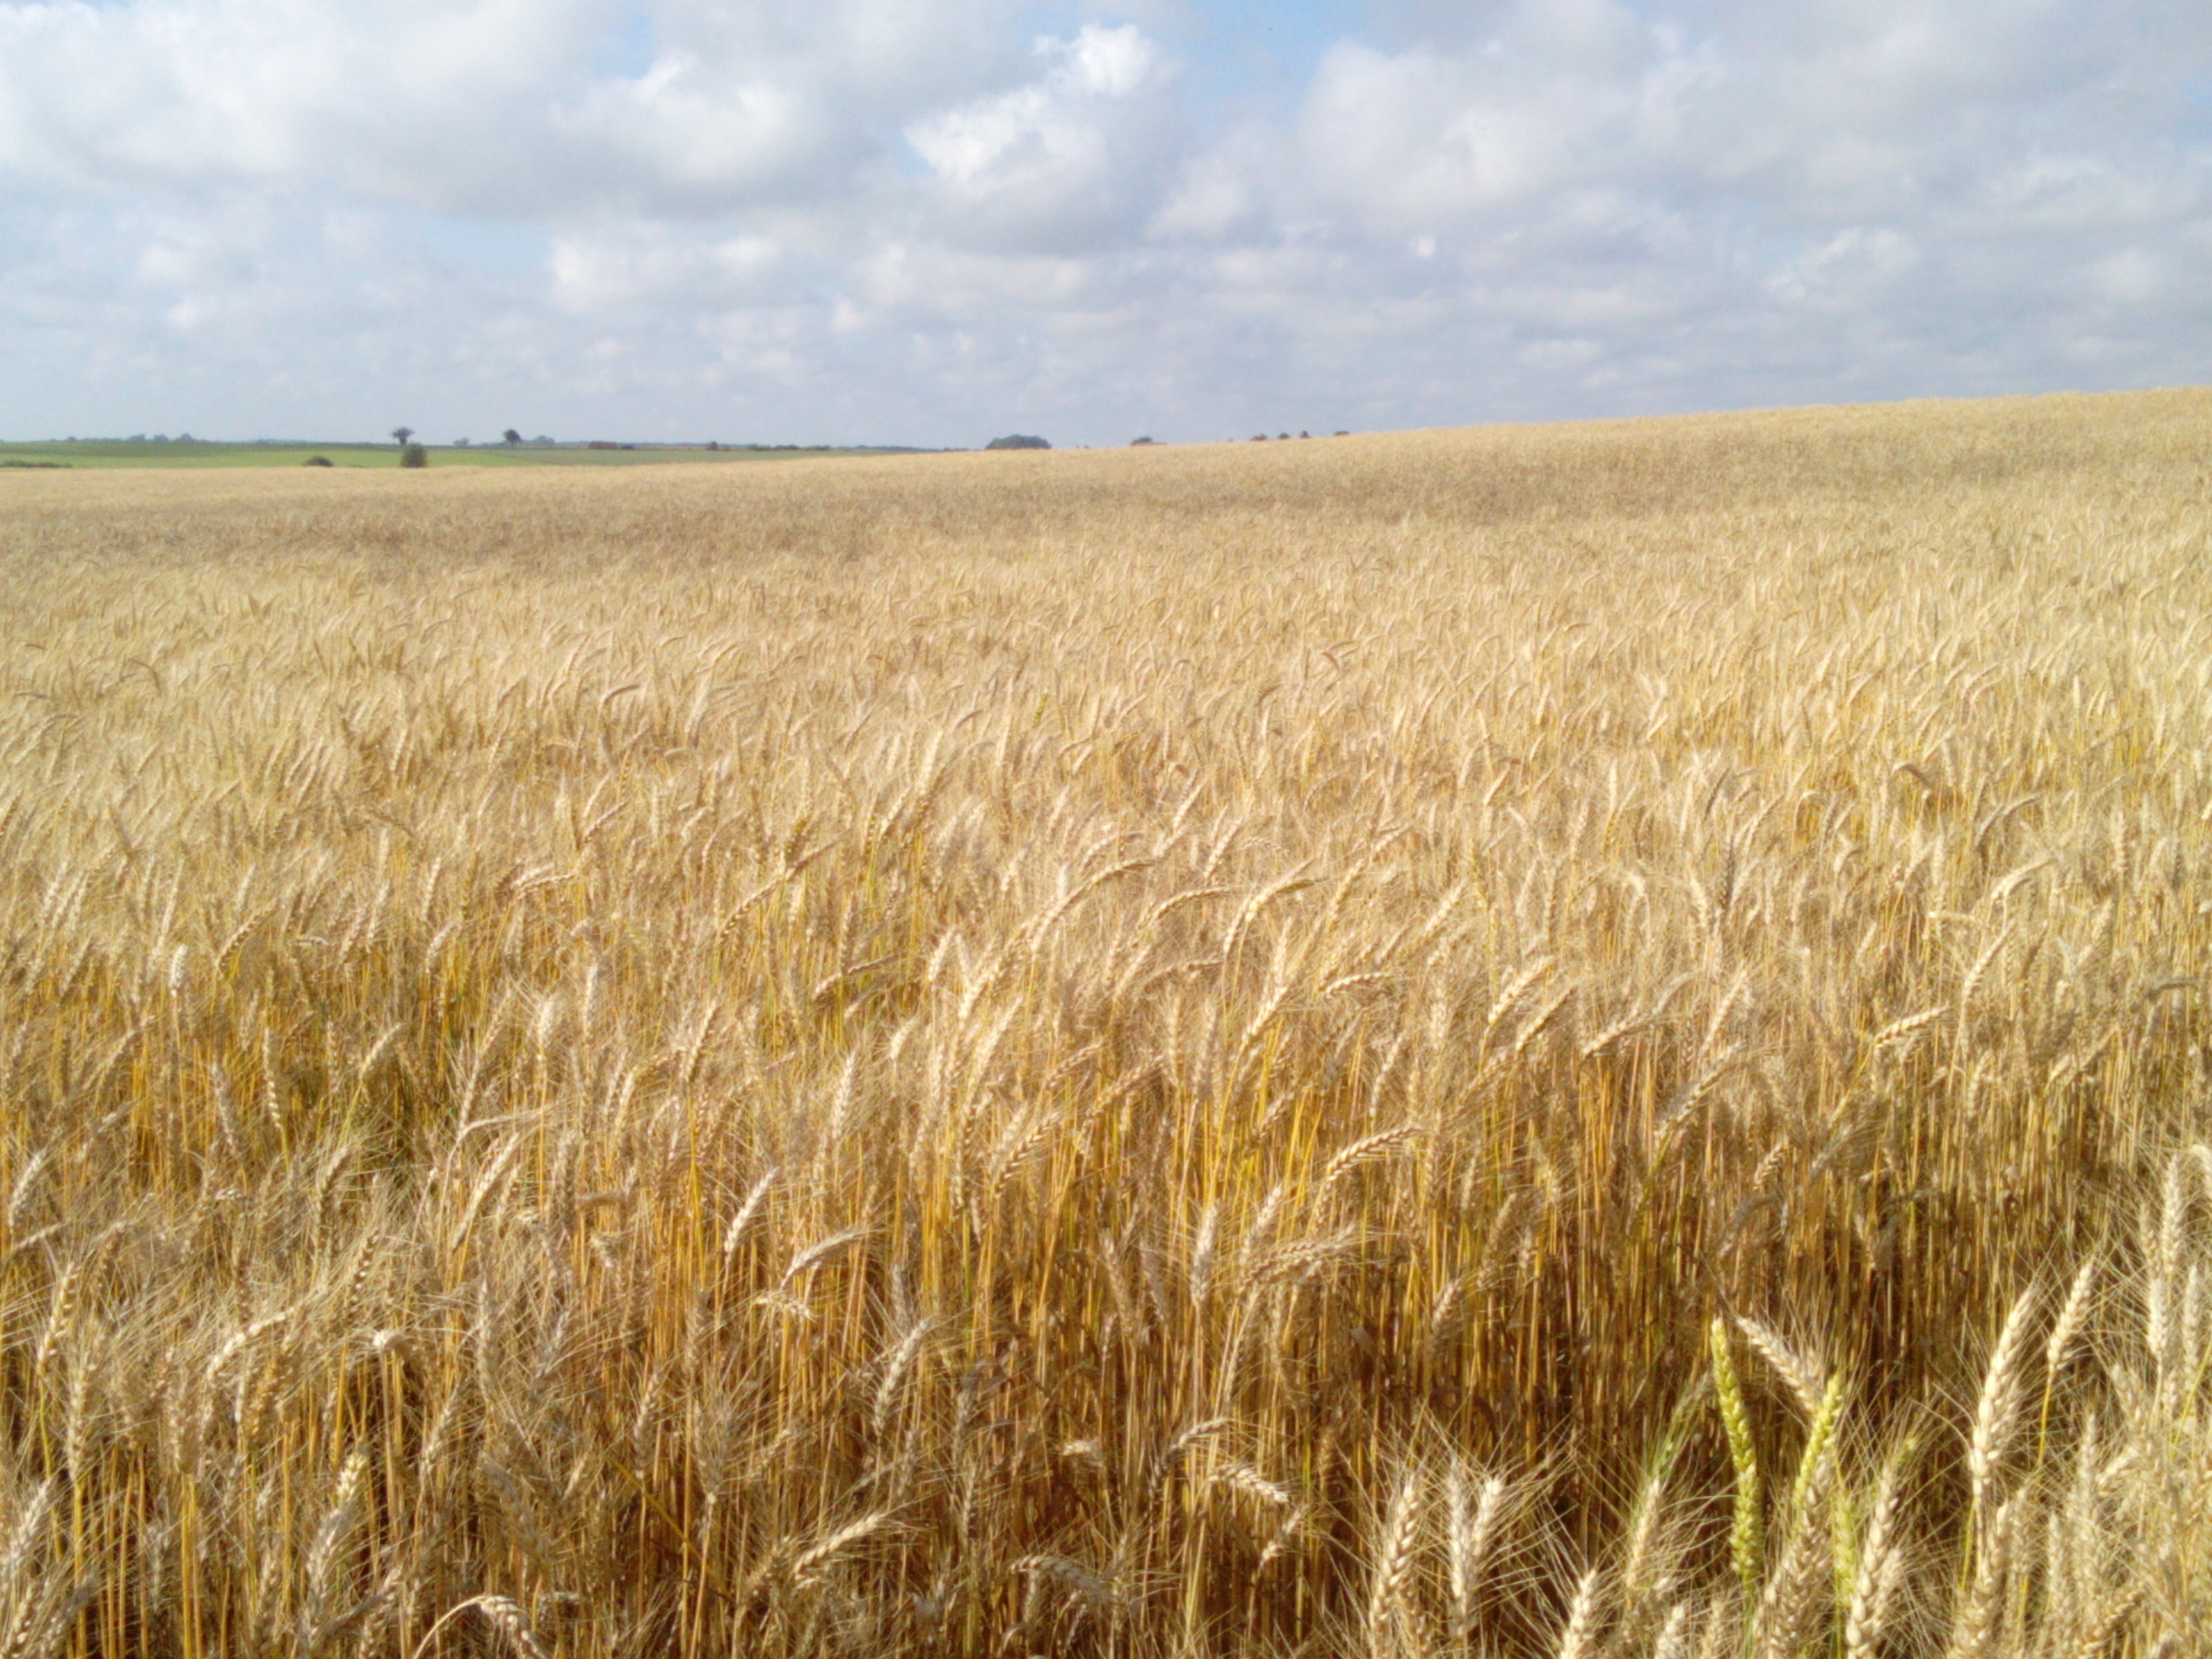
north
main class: Cropland
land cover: Common wheat
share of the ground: > 75 %
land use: Agriculture (excluding fallow land and kitchen gardens)
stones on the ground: 10 - 25 %
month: July
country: LV
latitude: 56.6494
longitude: 21.3090
